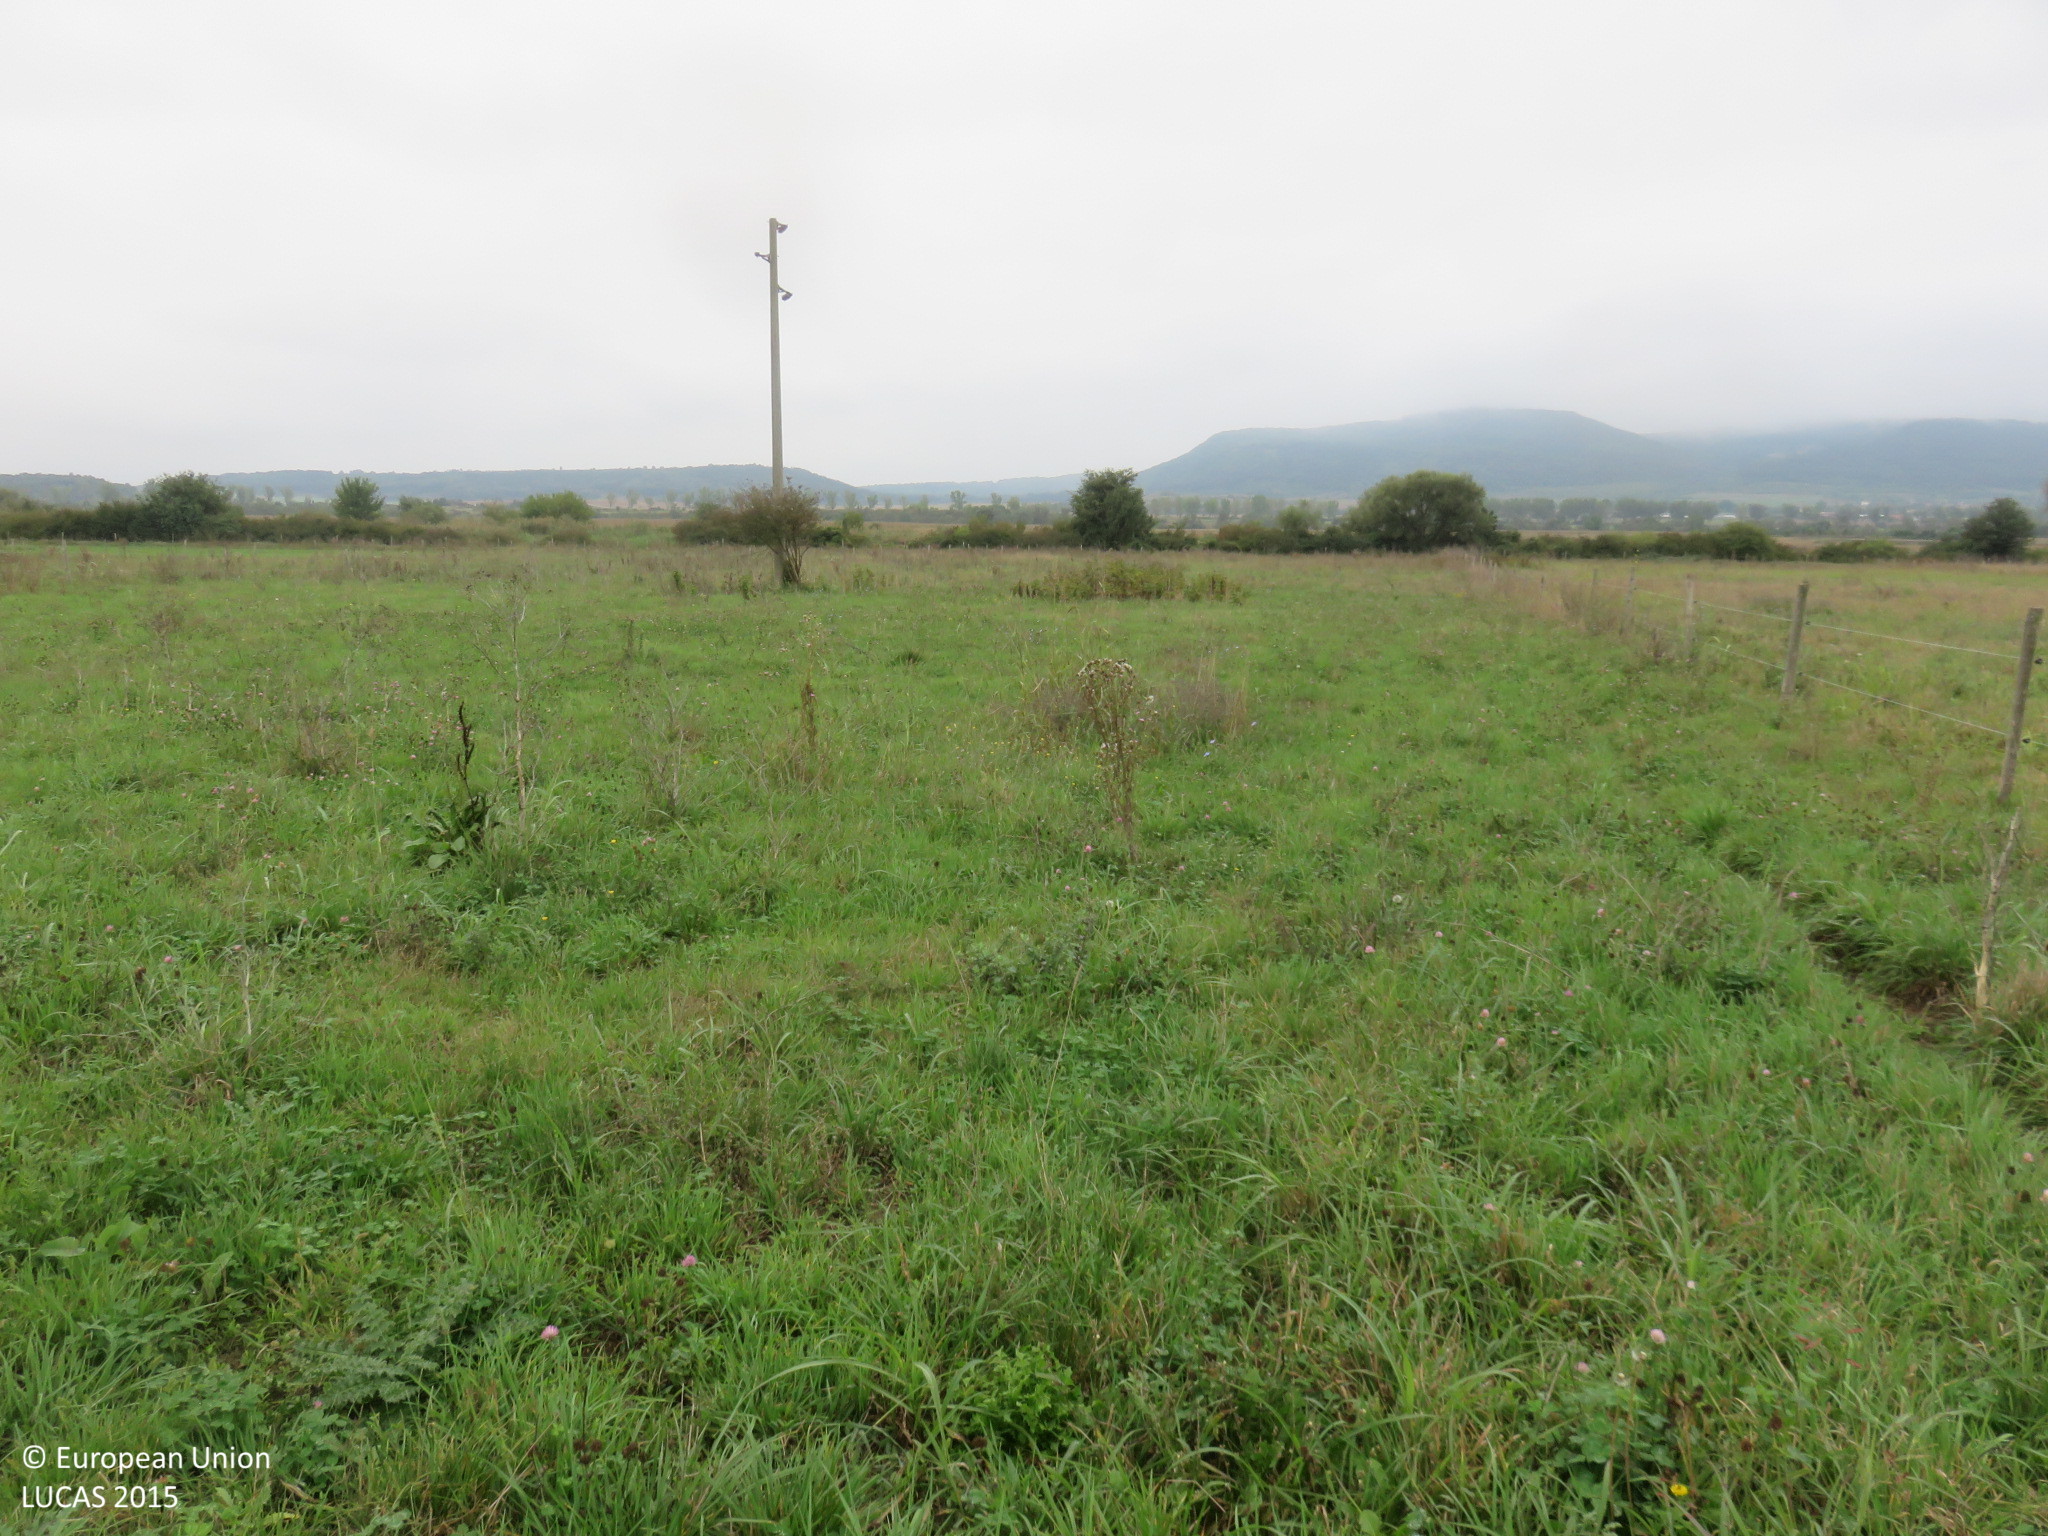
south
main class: Grassland
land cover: Grassland without tree/shrub cover
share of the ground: > 75 %
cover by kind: herbaceous plants 100 %
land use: Agriculture (excluding fallow land and kitchen gardens)
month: September
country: BG
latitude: 43.0466
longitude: 25.0314
